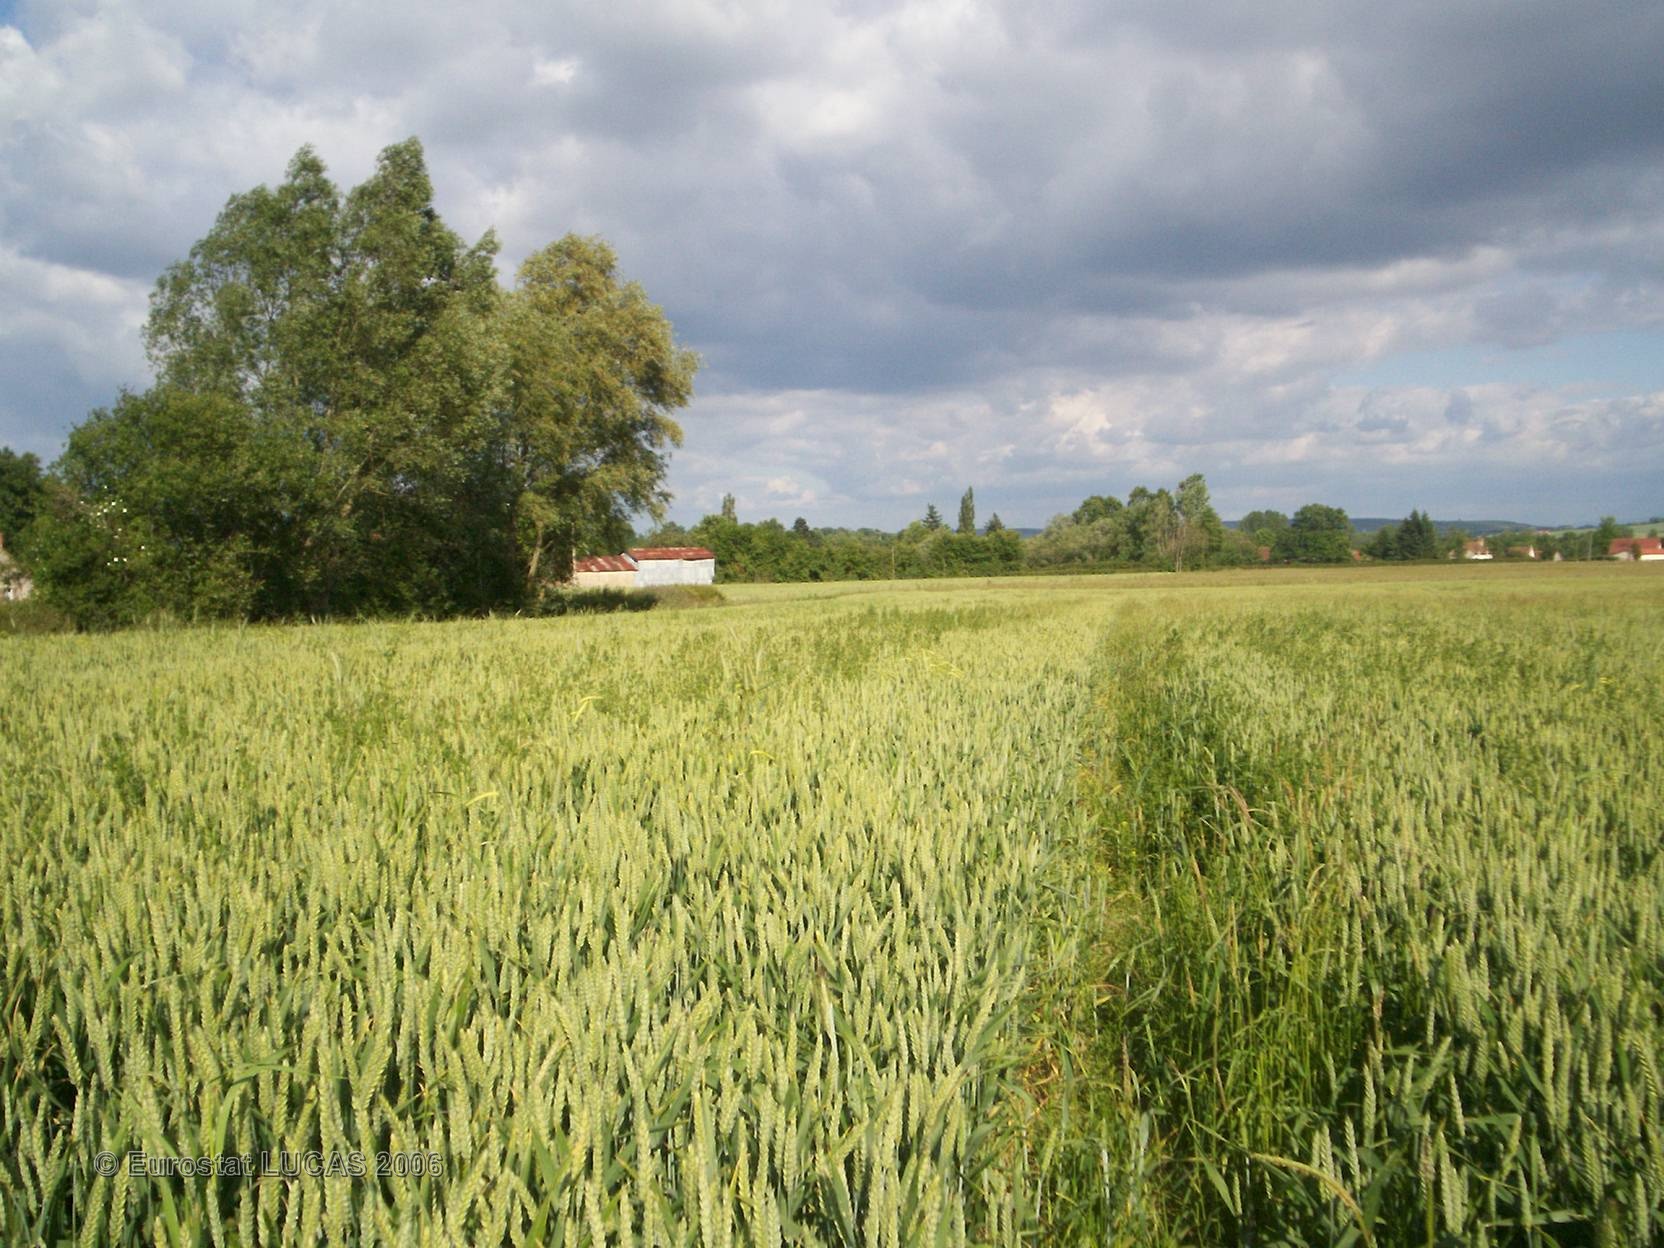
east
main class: Cropland
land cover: Common wheat
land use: Agriculture (excluding fallow land and kitchen gardens)
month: June
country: FR
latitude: 46.2196
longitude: 3.1146
